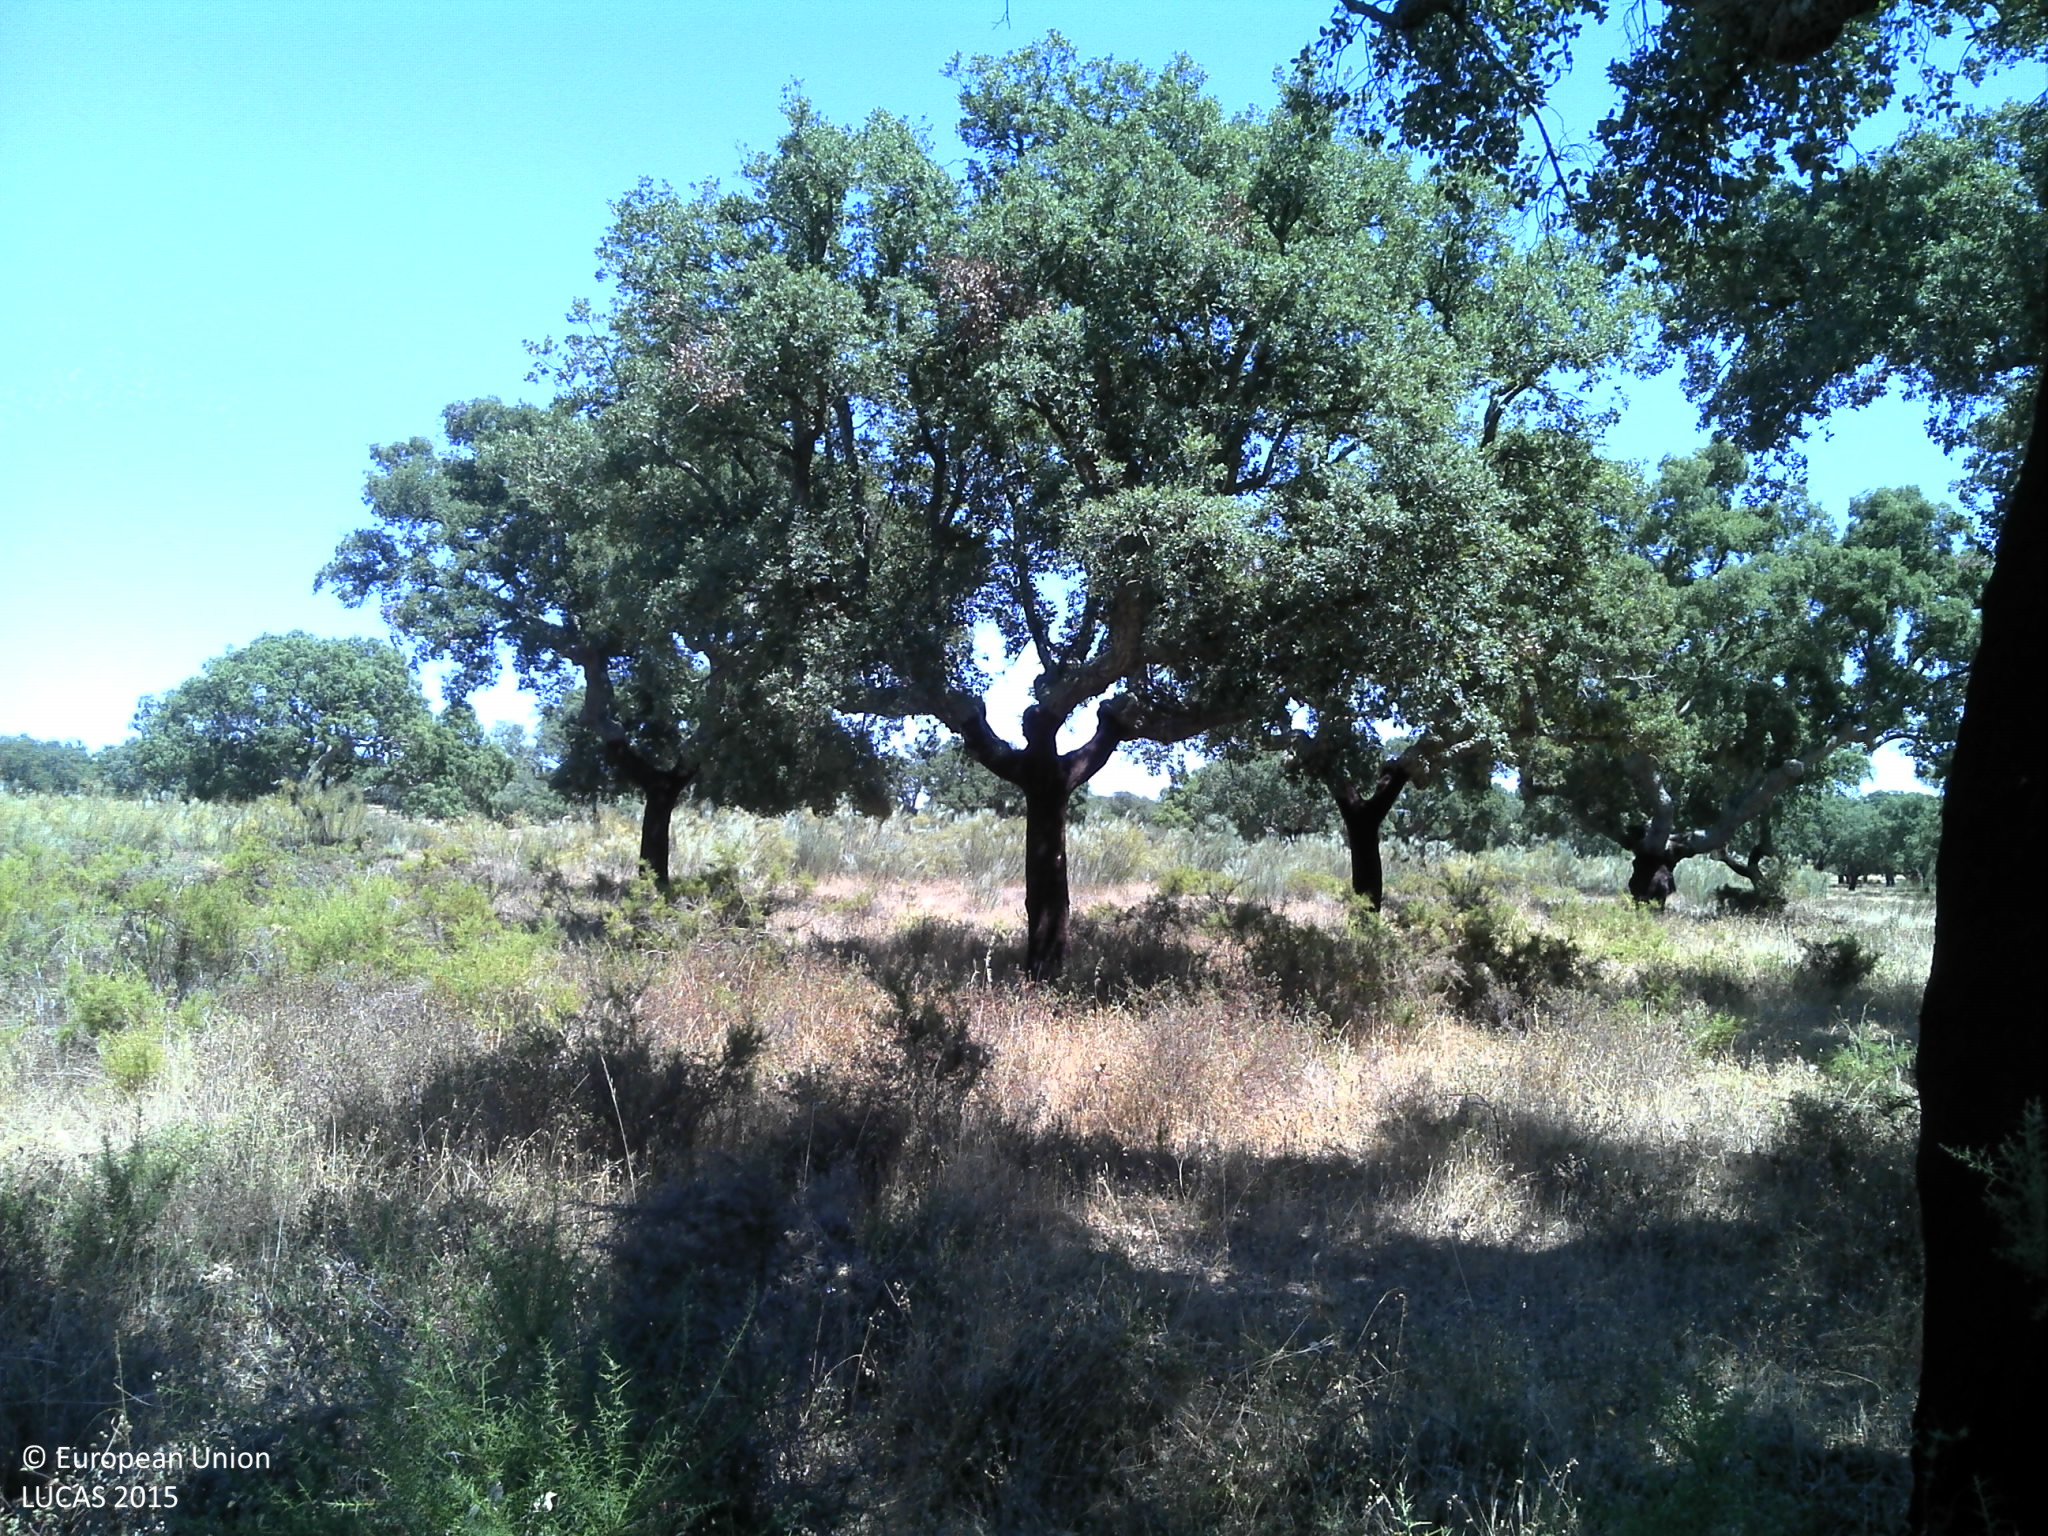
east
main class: Woodland
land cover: Broadleaved woodland
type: broadleaved evergreen forest
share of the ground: 10 - 25 %
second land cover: Shrubland without tree cover
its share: > 75 %
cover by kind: shrubs 90 %, broadleaved forest trees 10 %
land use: Forestry
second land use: Agriculture (excluding fallow land and kitchen gardens)
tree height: > 5 m
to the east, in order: Broadleaved woodland; Shrubland without tree cover; Broadleaved woodland; Shrubland without tree cover; Broadleaved woodland; Fences; Other structural elements
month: July
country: PT
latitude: 39.1692
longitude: -7.5541
